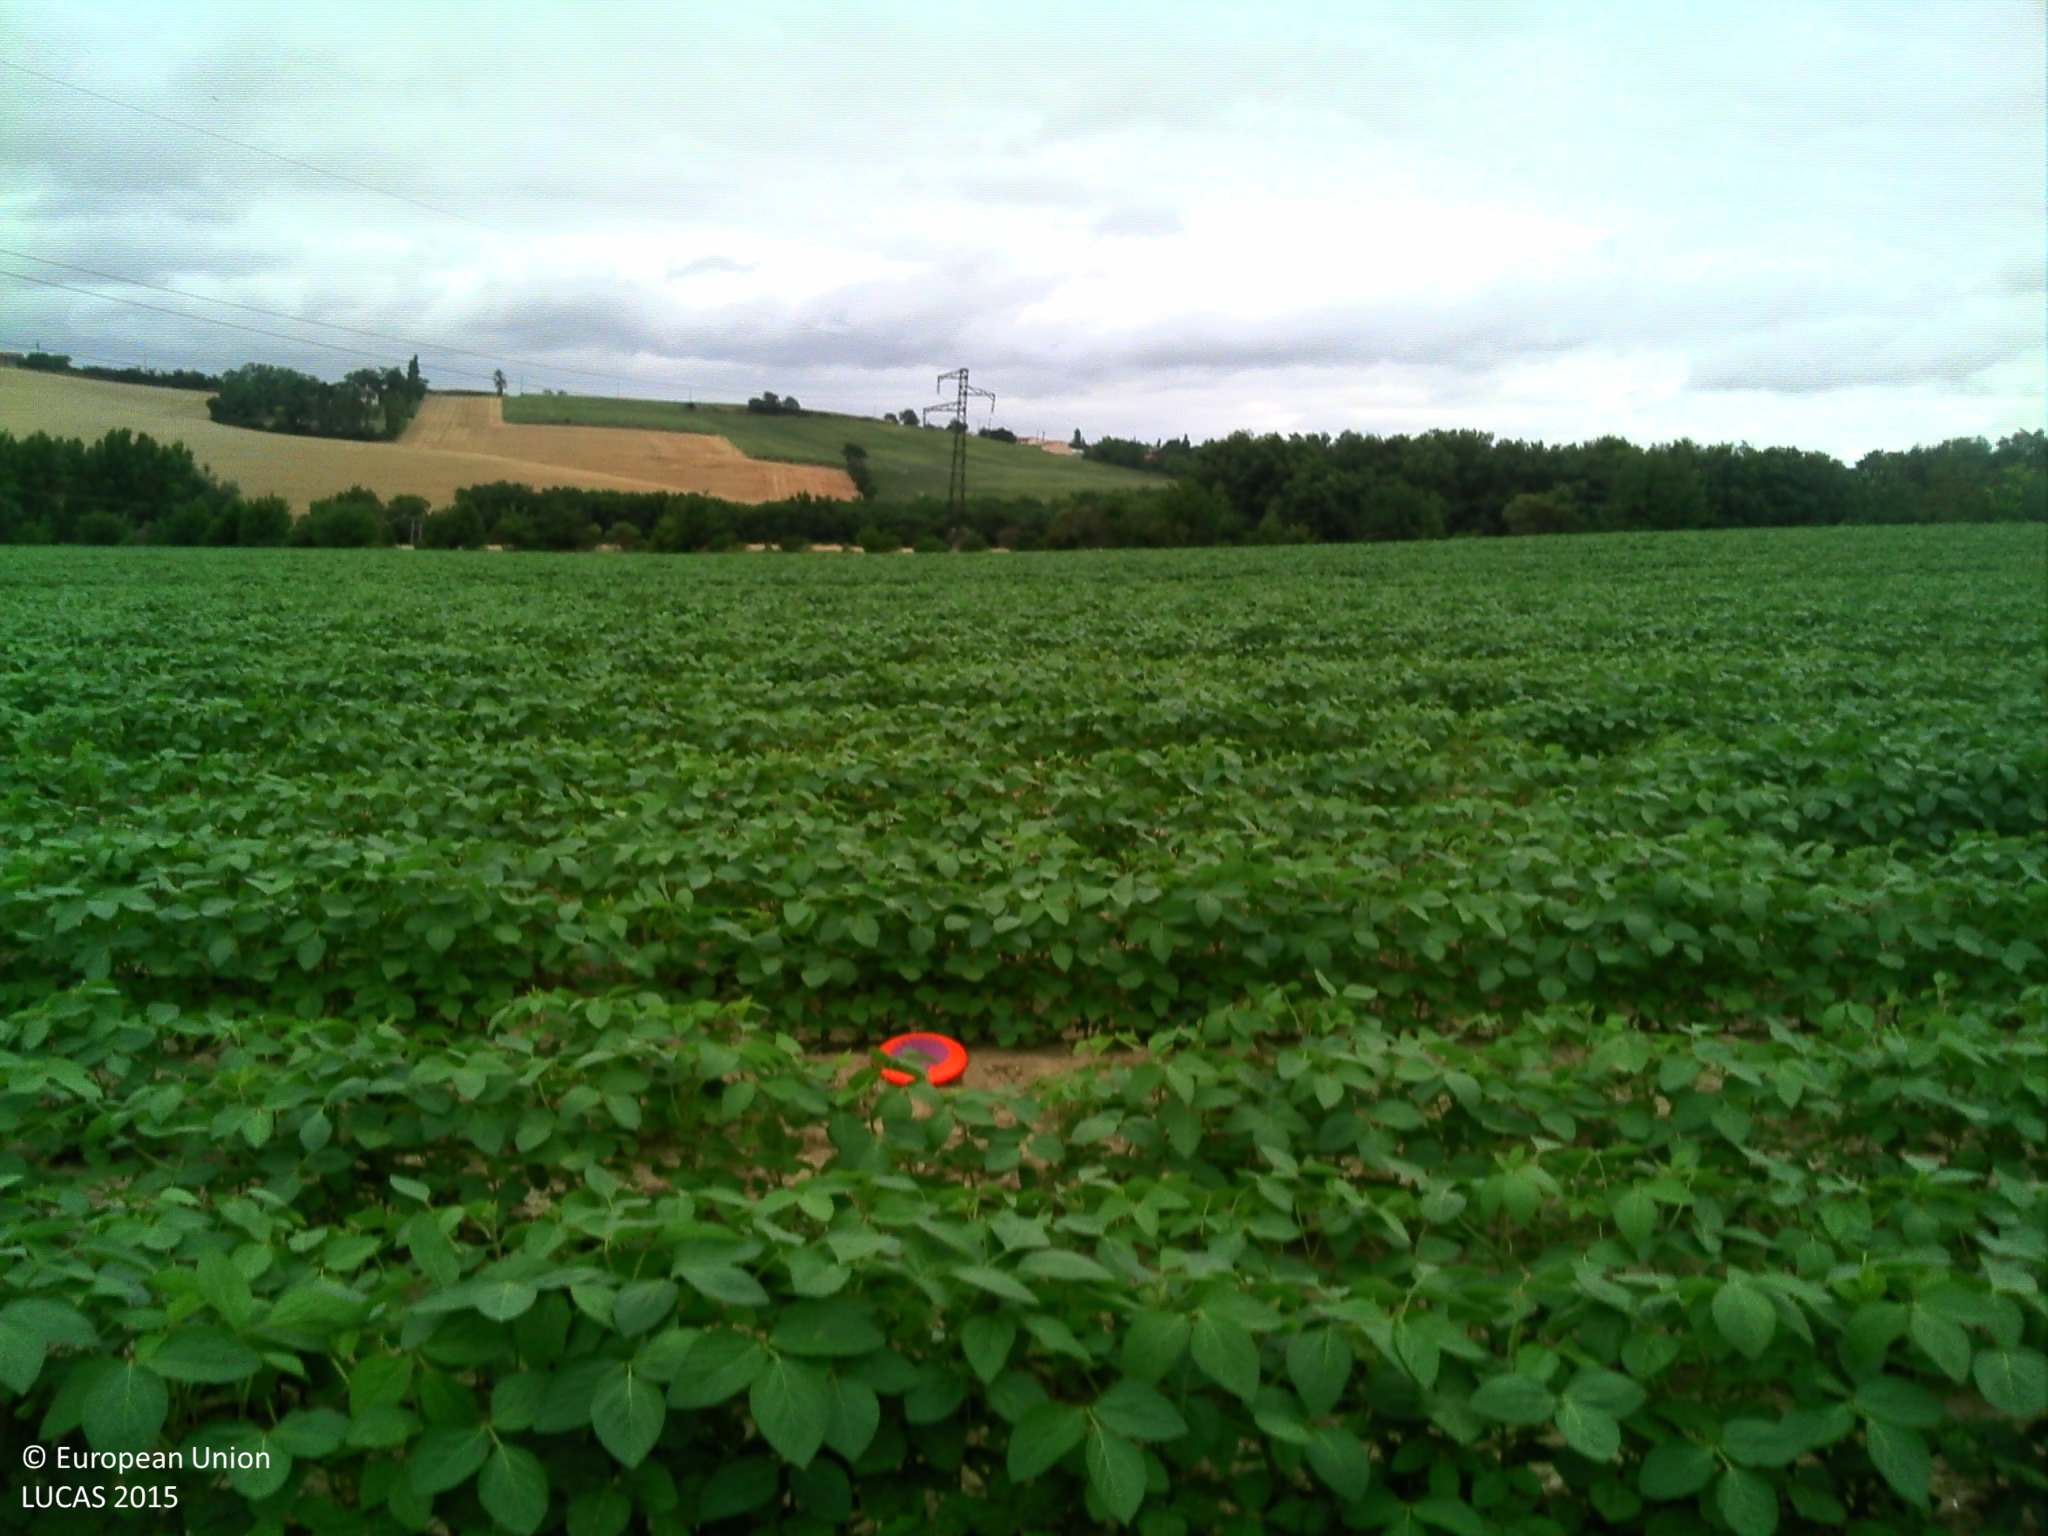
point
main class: Cropland
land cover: Soya
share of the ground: > 75 %
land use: Agriculture (excluding fallow land and kitchen gardens)
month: July
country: FR
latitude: 43.4845
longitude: 1.6086
